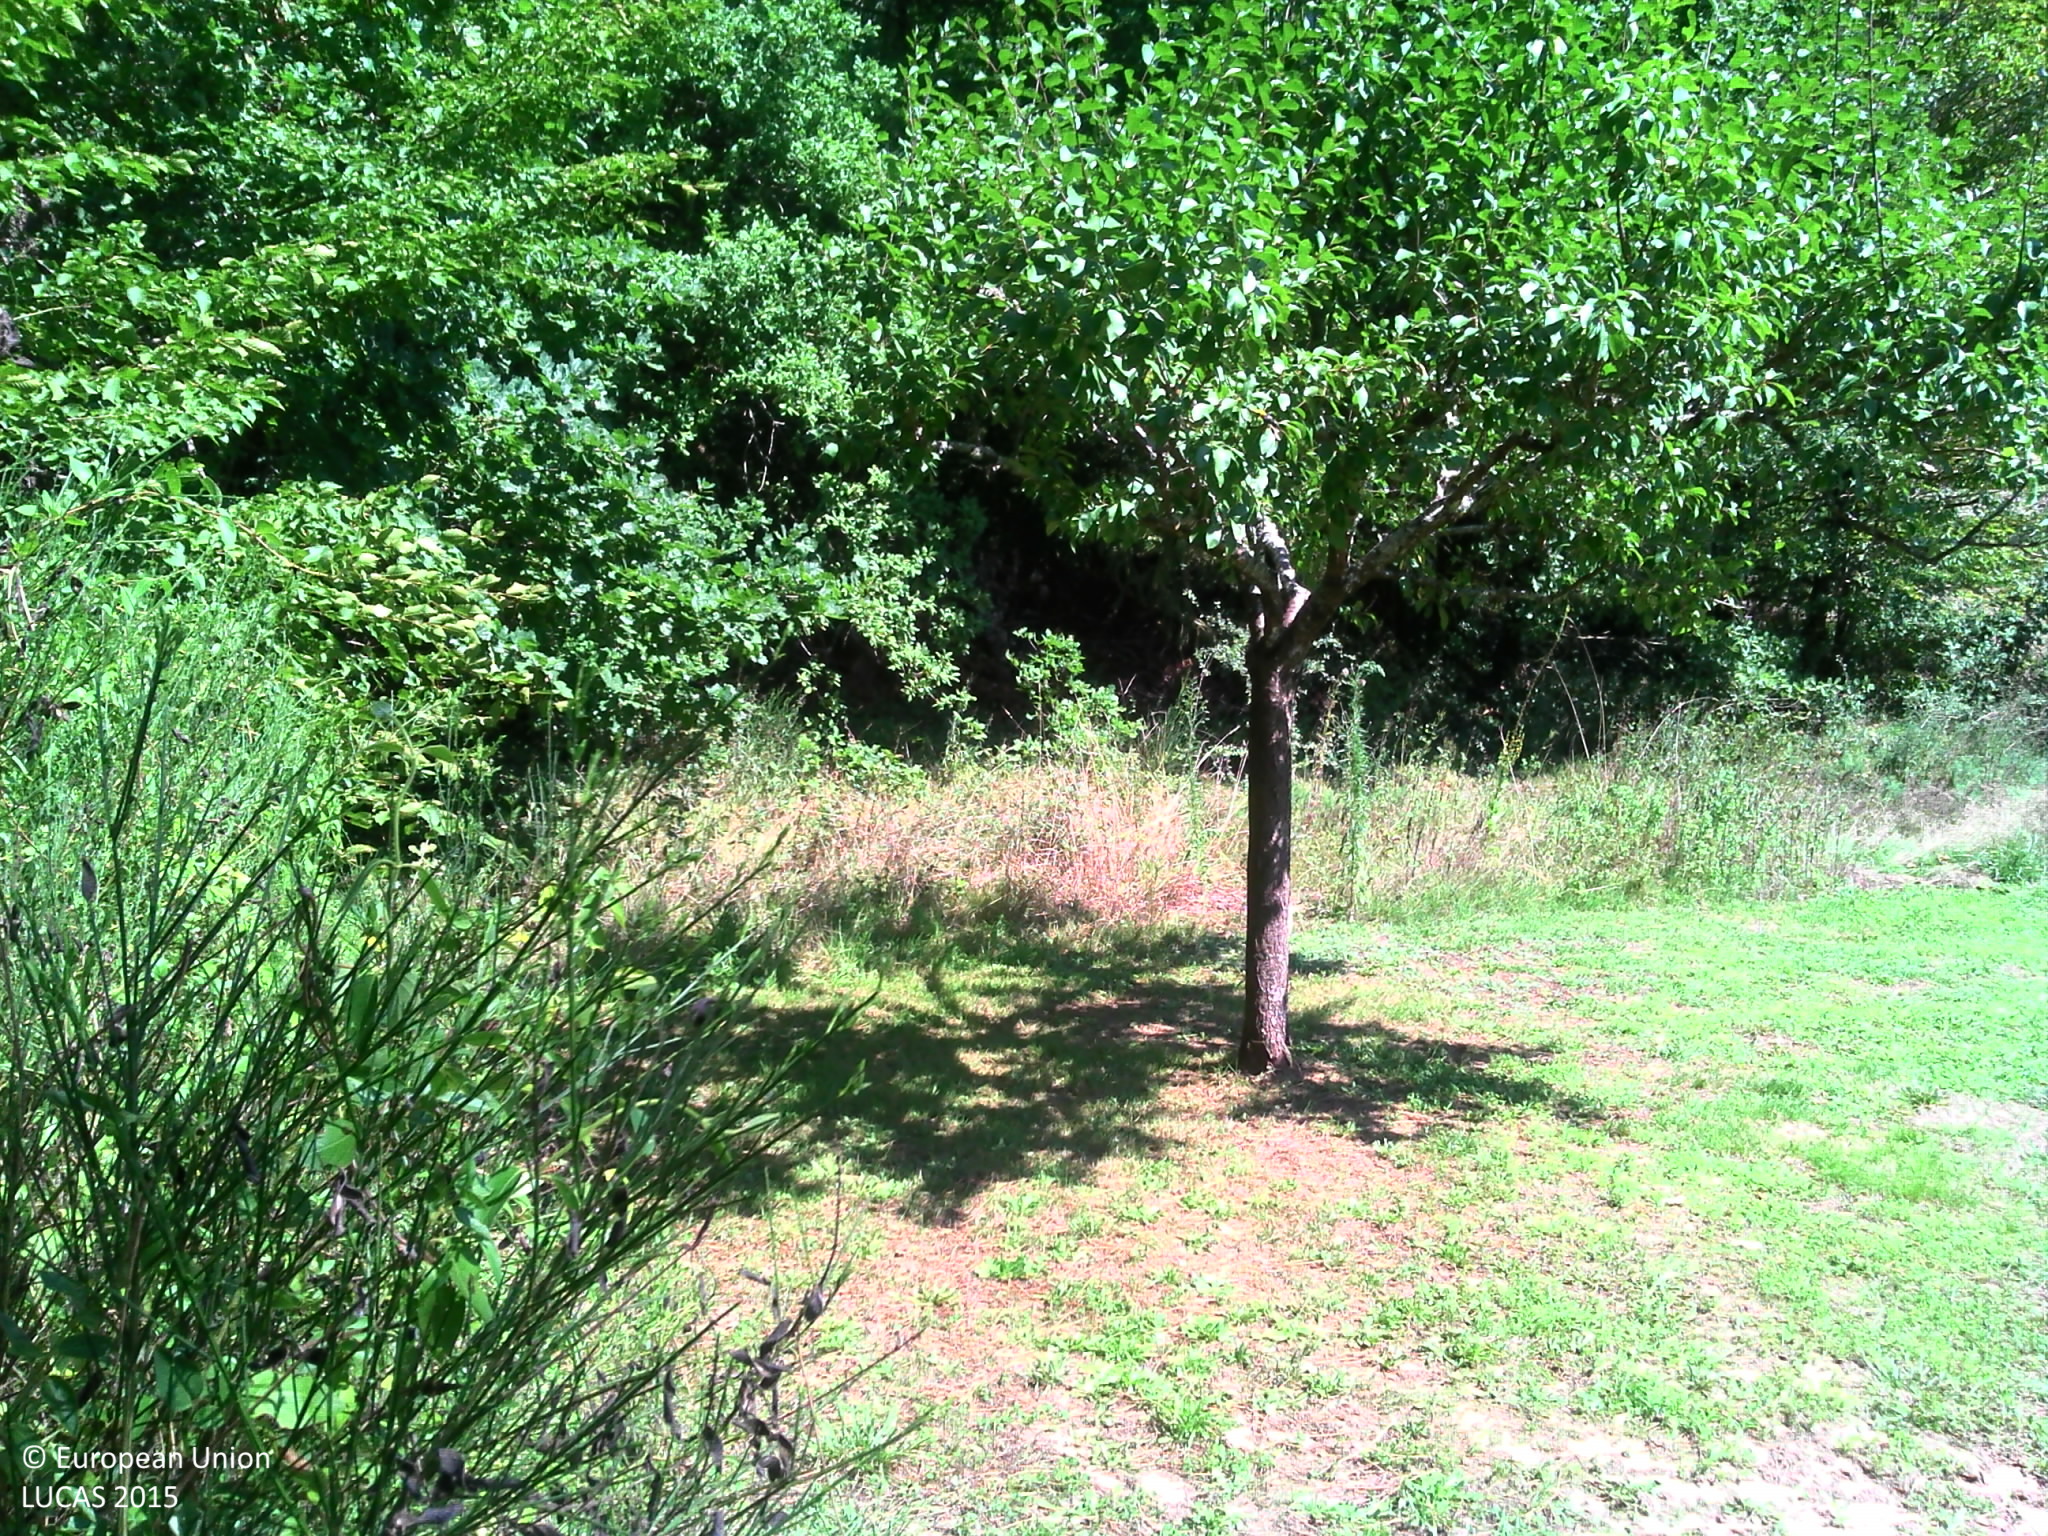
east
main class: Woodland
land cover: Pine dominated mixed woodland
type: coniferous forest of the mediterranean region
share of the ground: > 75 %
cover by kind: broadleaved forest trees 60 %, coniferous forest trees 30 %, shrubs 10 %
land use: Forestry
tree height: > 5 m
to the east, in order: Pine dominated mixed woodland; Spontaneously vegetated surfaces; Pine dominated mixed woodland; Broadleaved woodland; Tracks; Broadleaved woodland
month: August
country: FR
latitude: 44.6076
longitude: 1.1631
